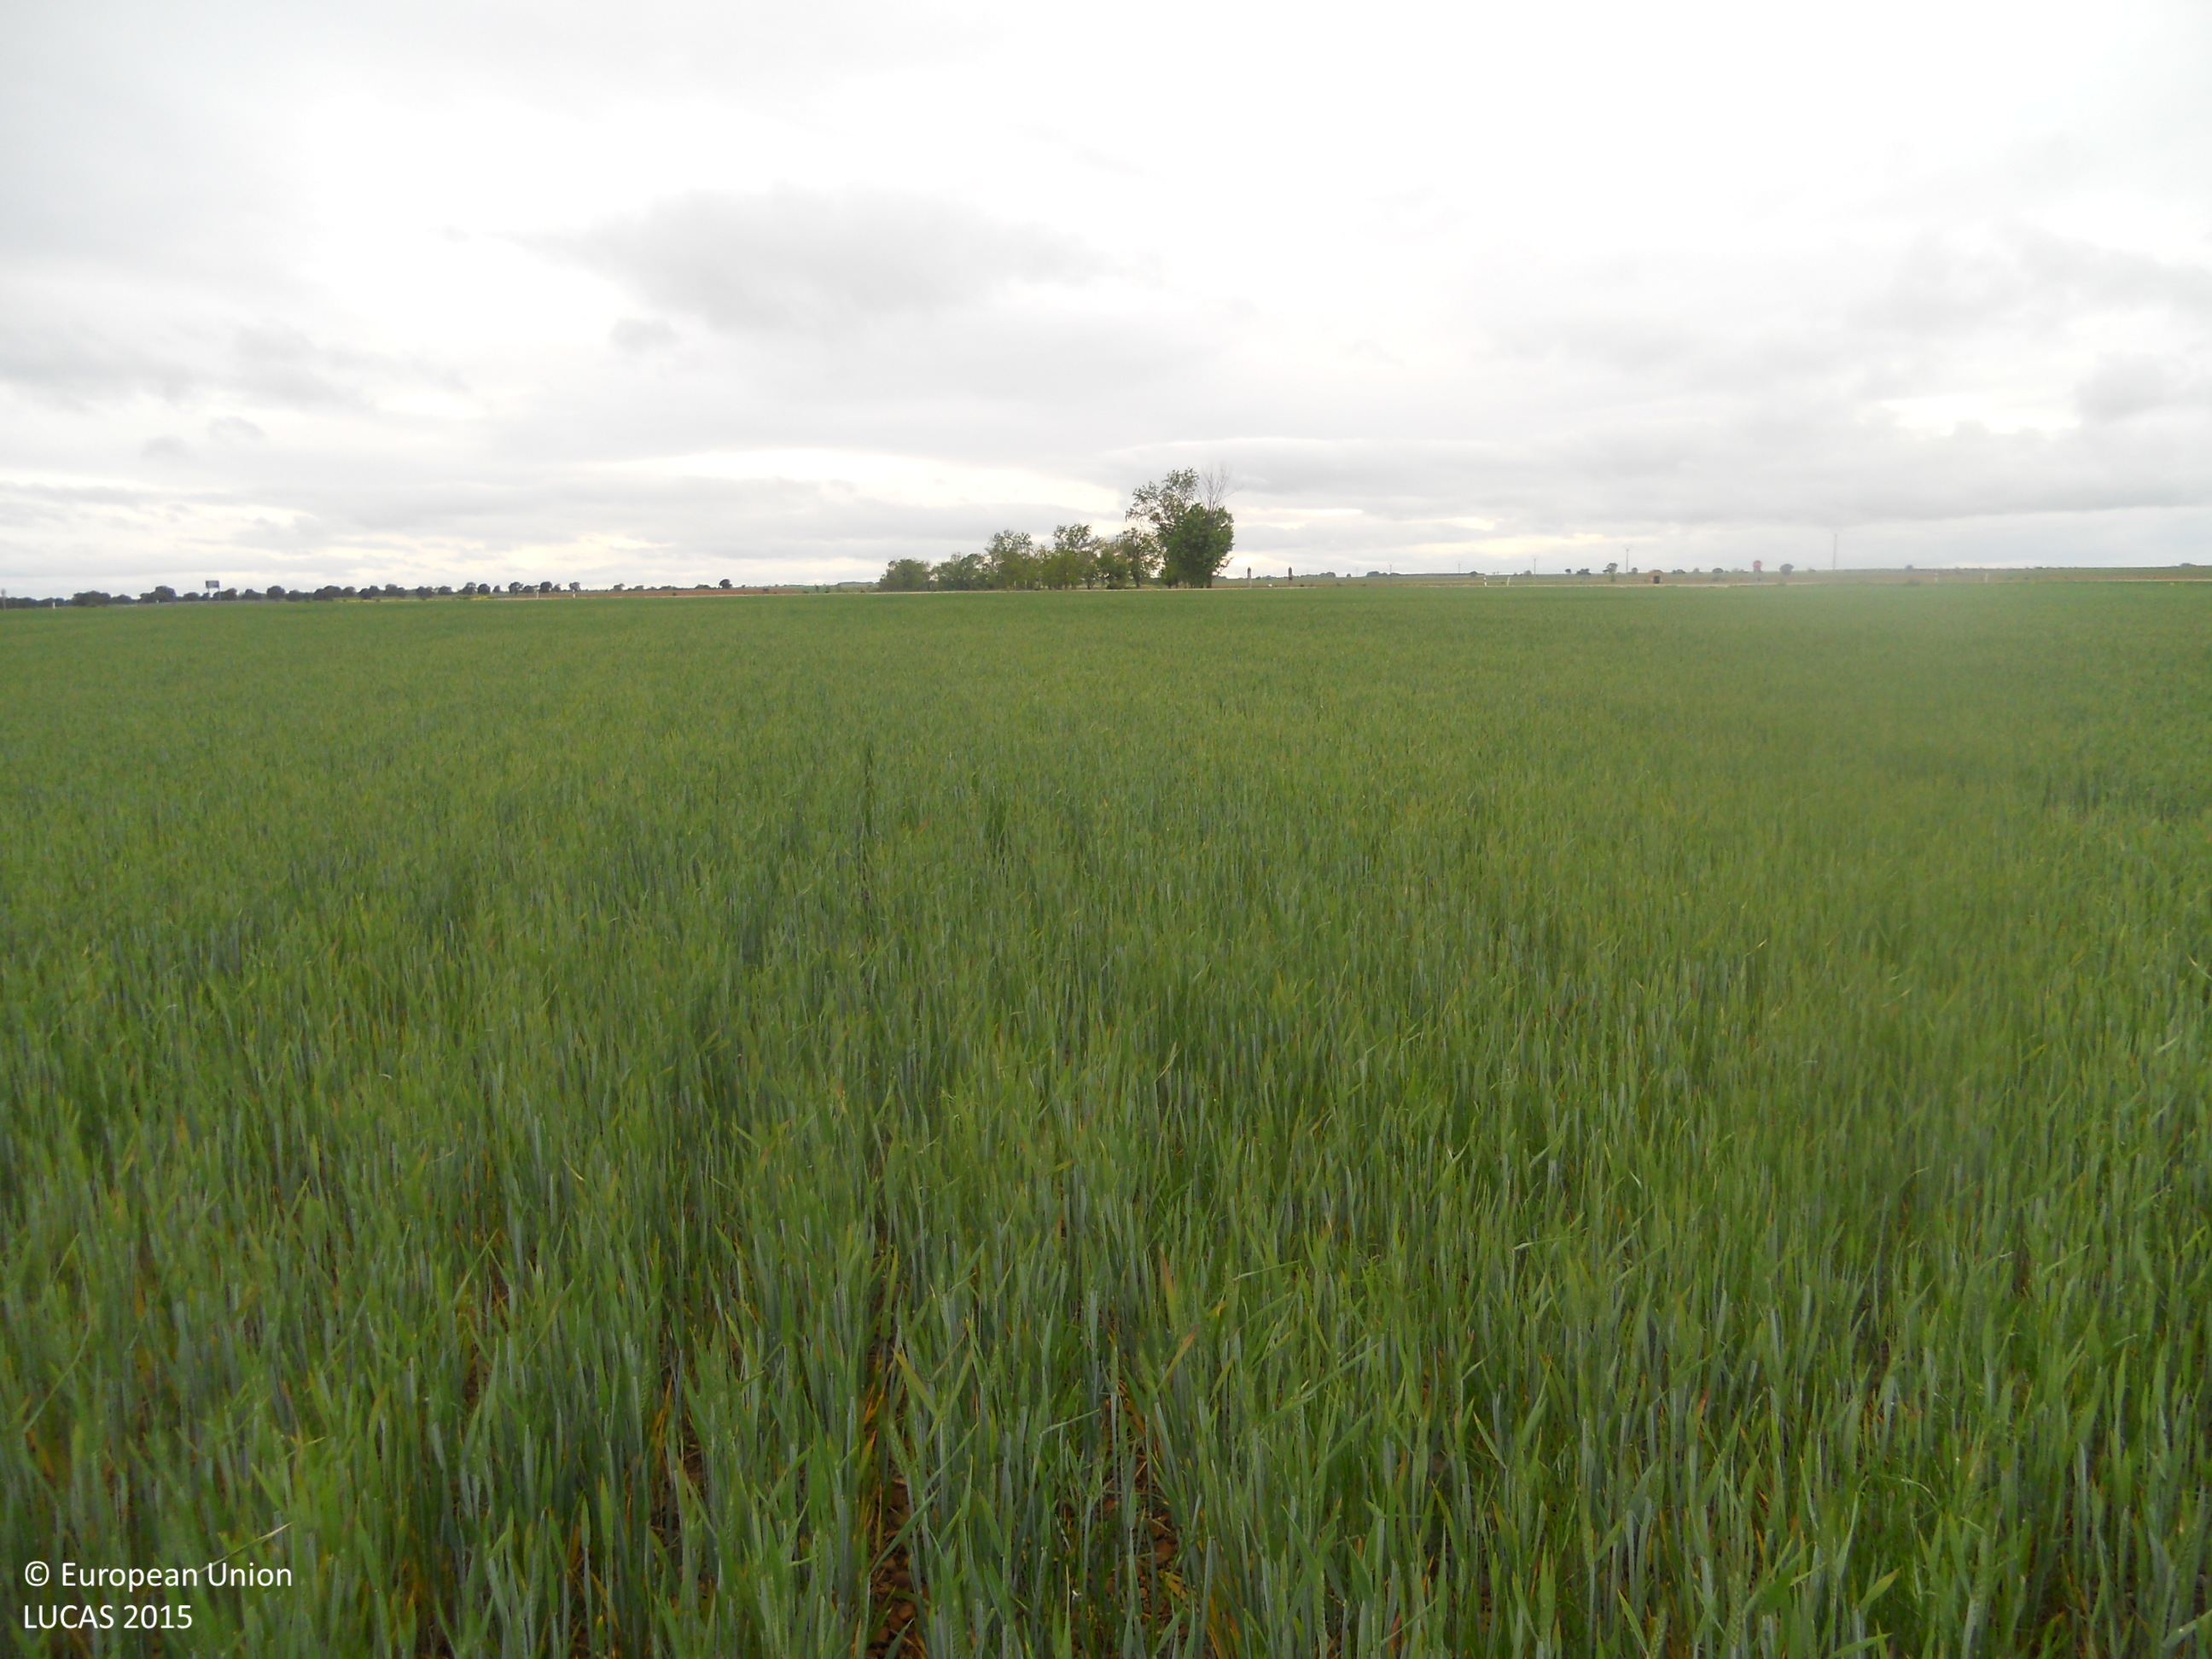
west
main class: Cropland
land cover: Common wheat
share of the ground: > 75 %
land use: Agriculture (excluding fallow land and kitchen gardens)
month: May
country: ES
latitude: 42.2227
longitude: -5.2666
